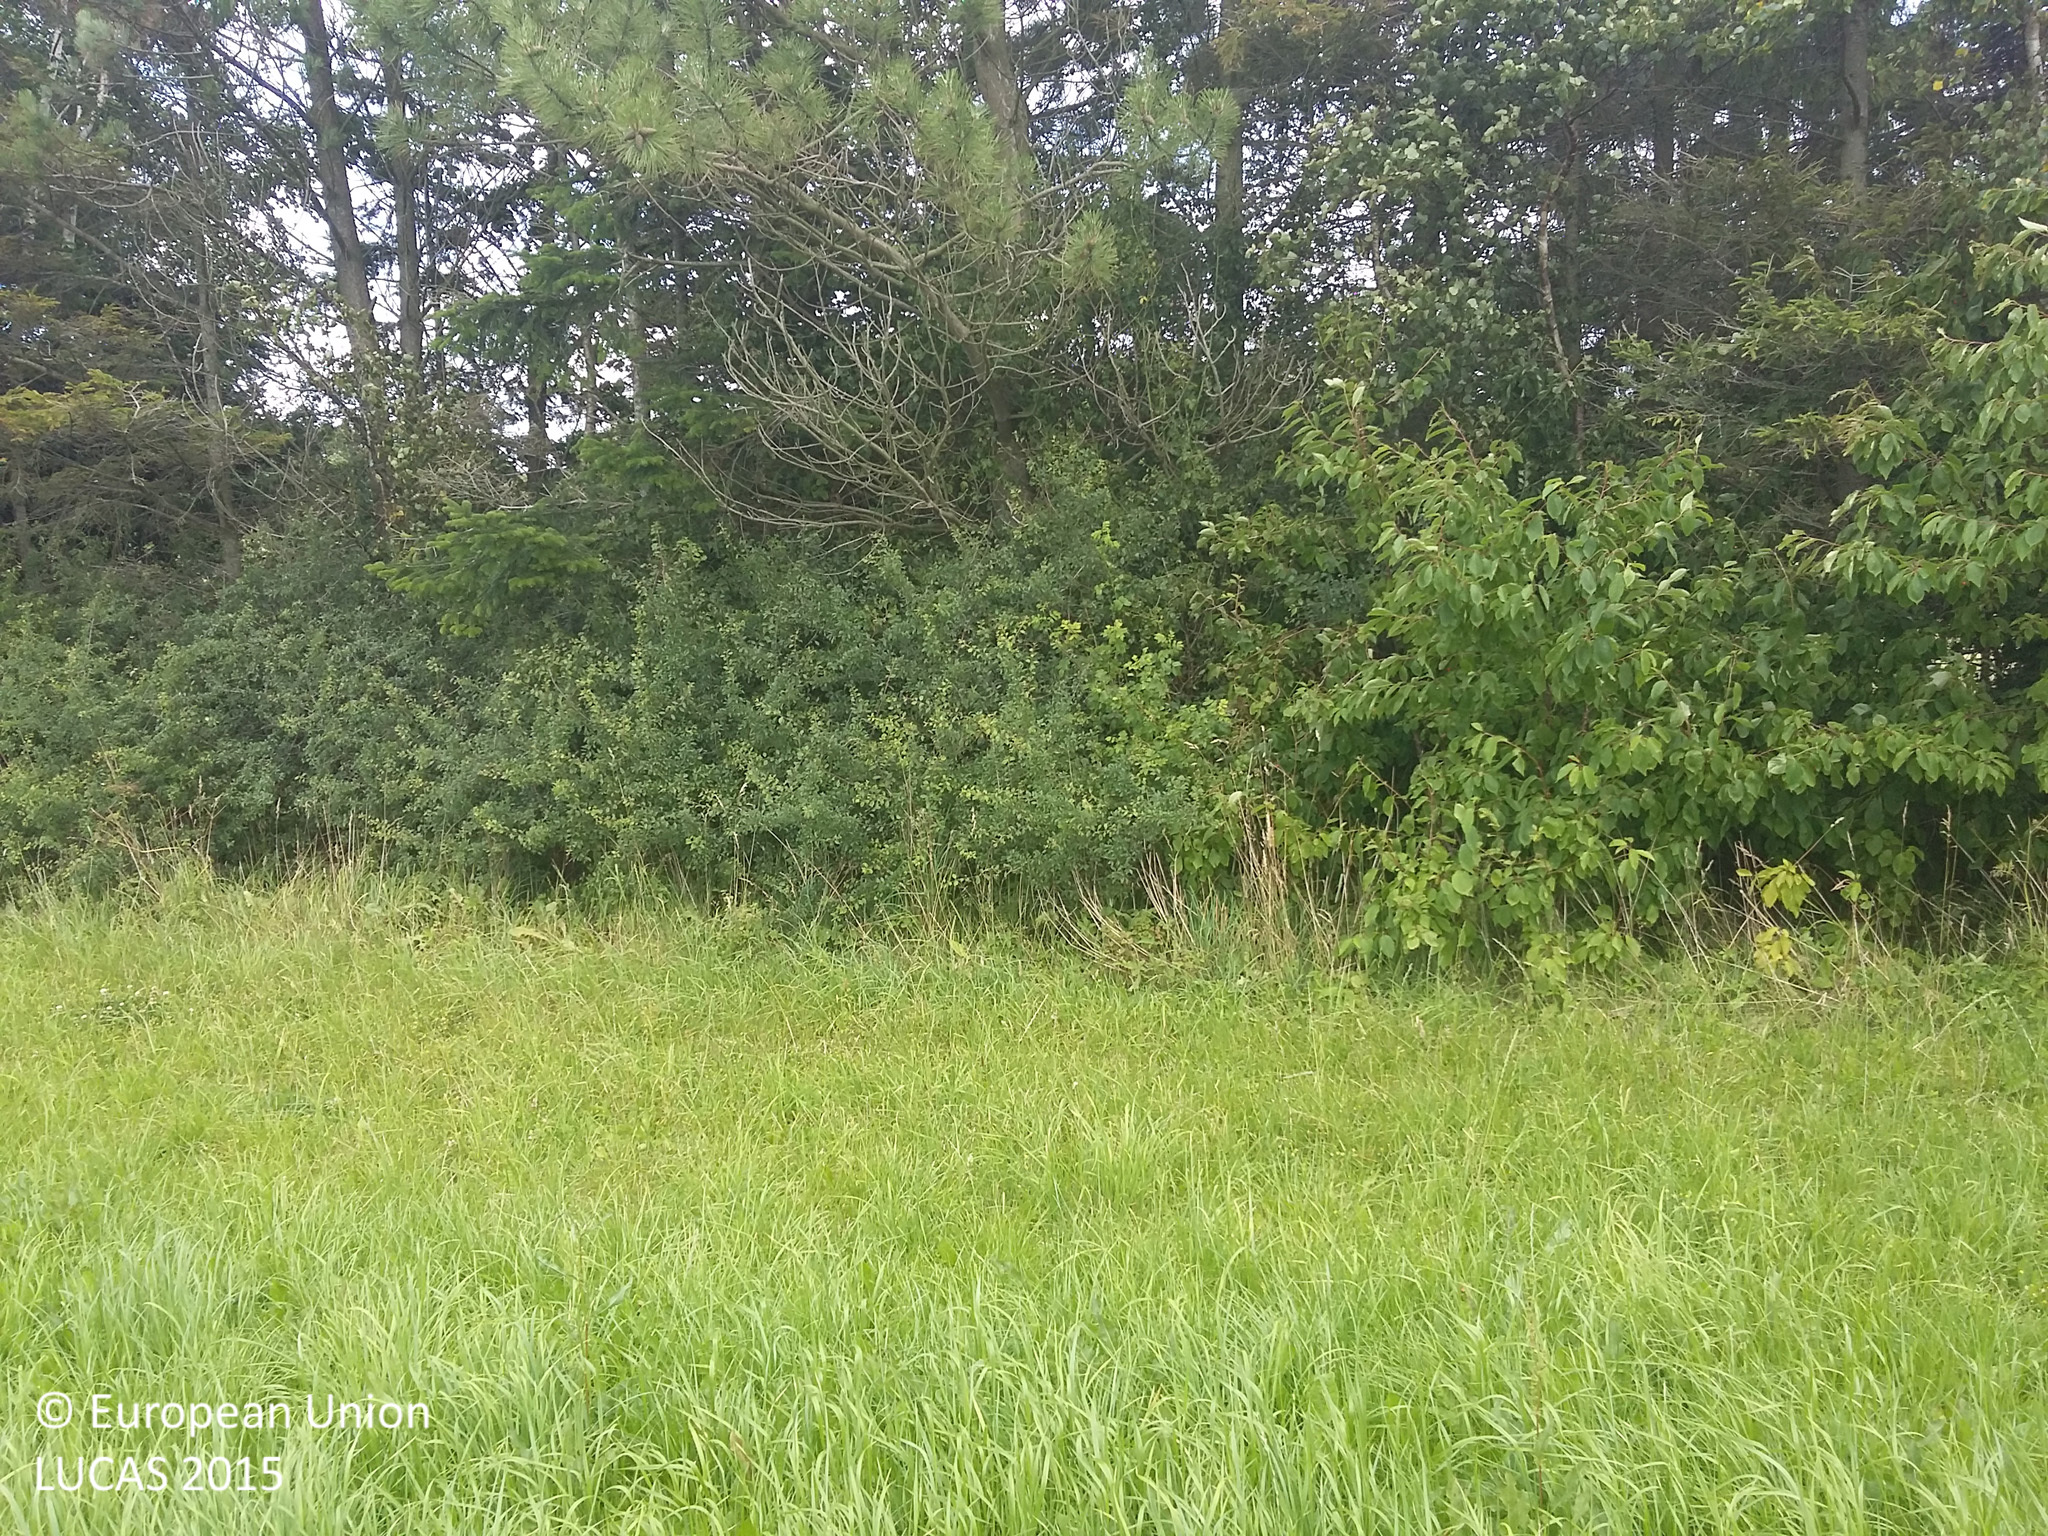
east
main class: Grassland
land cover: Grassland without tree/shrub cover
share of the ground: > 75 %
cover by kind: herbaceous plants 100 %
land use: Agriculture (excluding fallow land and kitchen gardens)
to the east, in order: Grassland without tree/shrub cover; Other mixed woodland; Paved roads, cycling and walking lanes; Abandoned hedges; Common wheat; Broadleaved woodland; Grassland without tree/shrub cover; Broadleaved woodland; Inland fresh water bodies
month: July
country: DK
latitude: 56.0605
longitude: 12.2302
